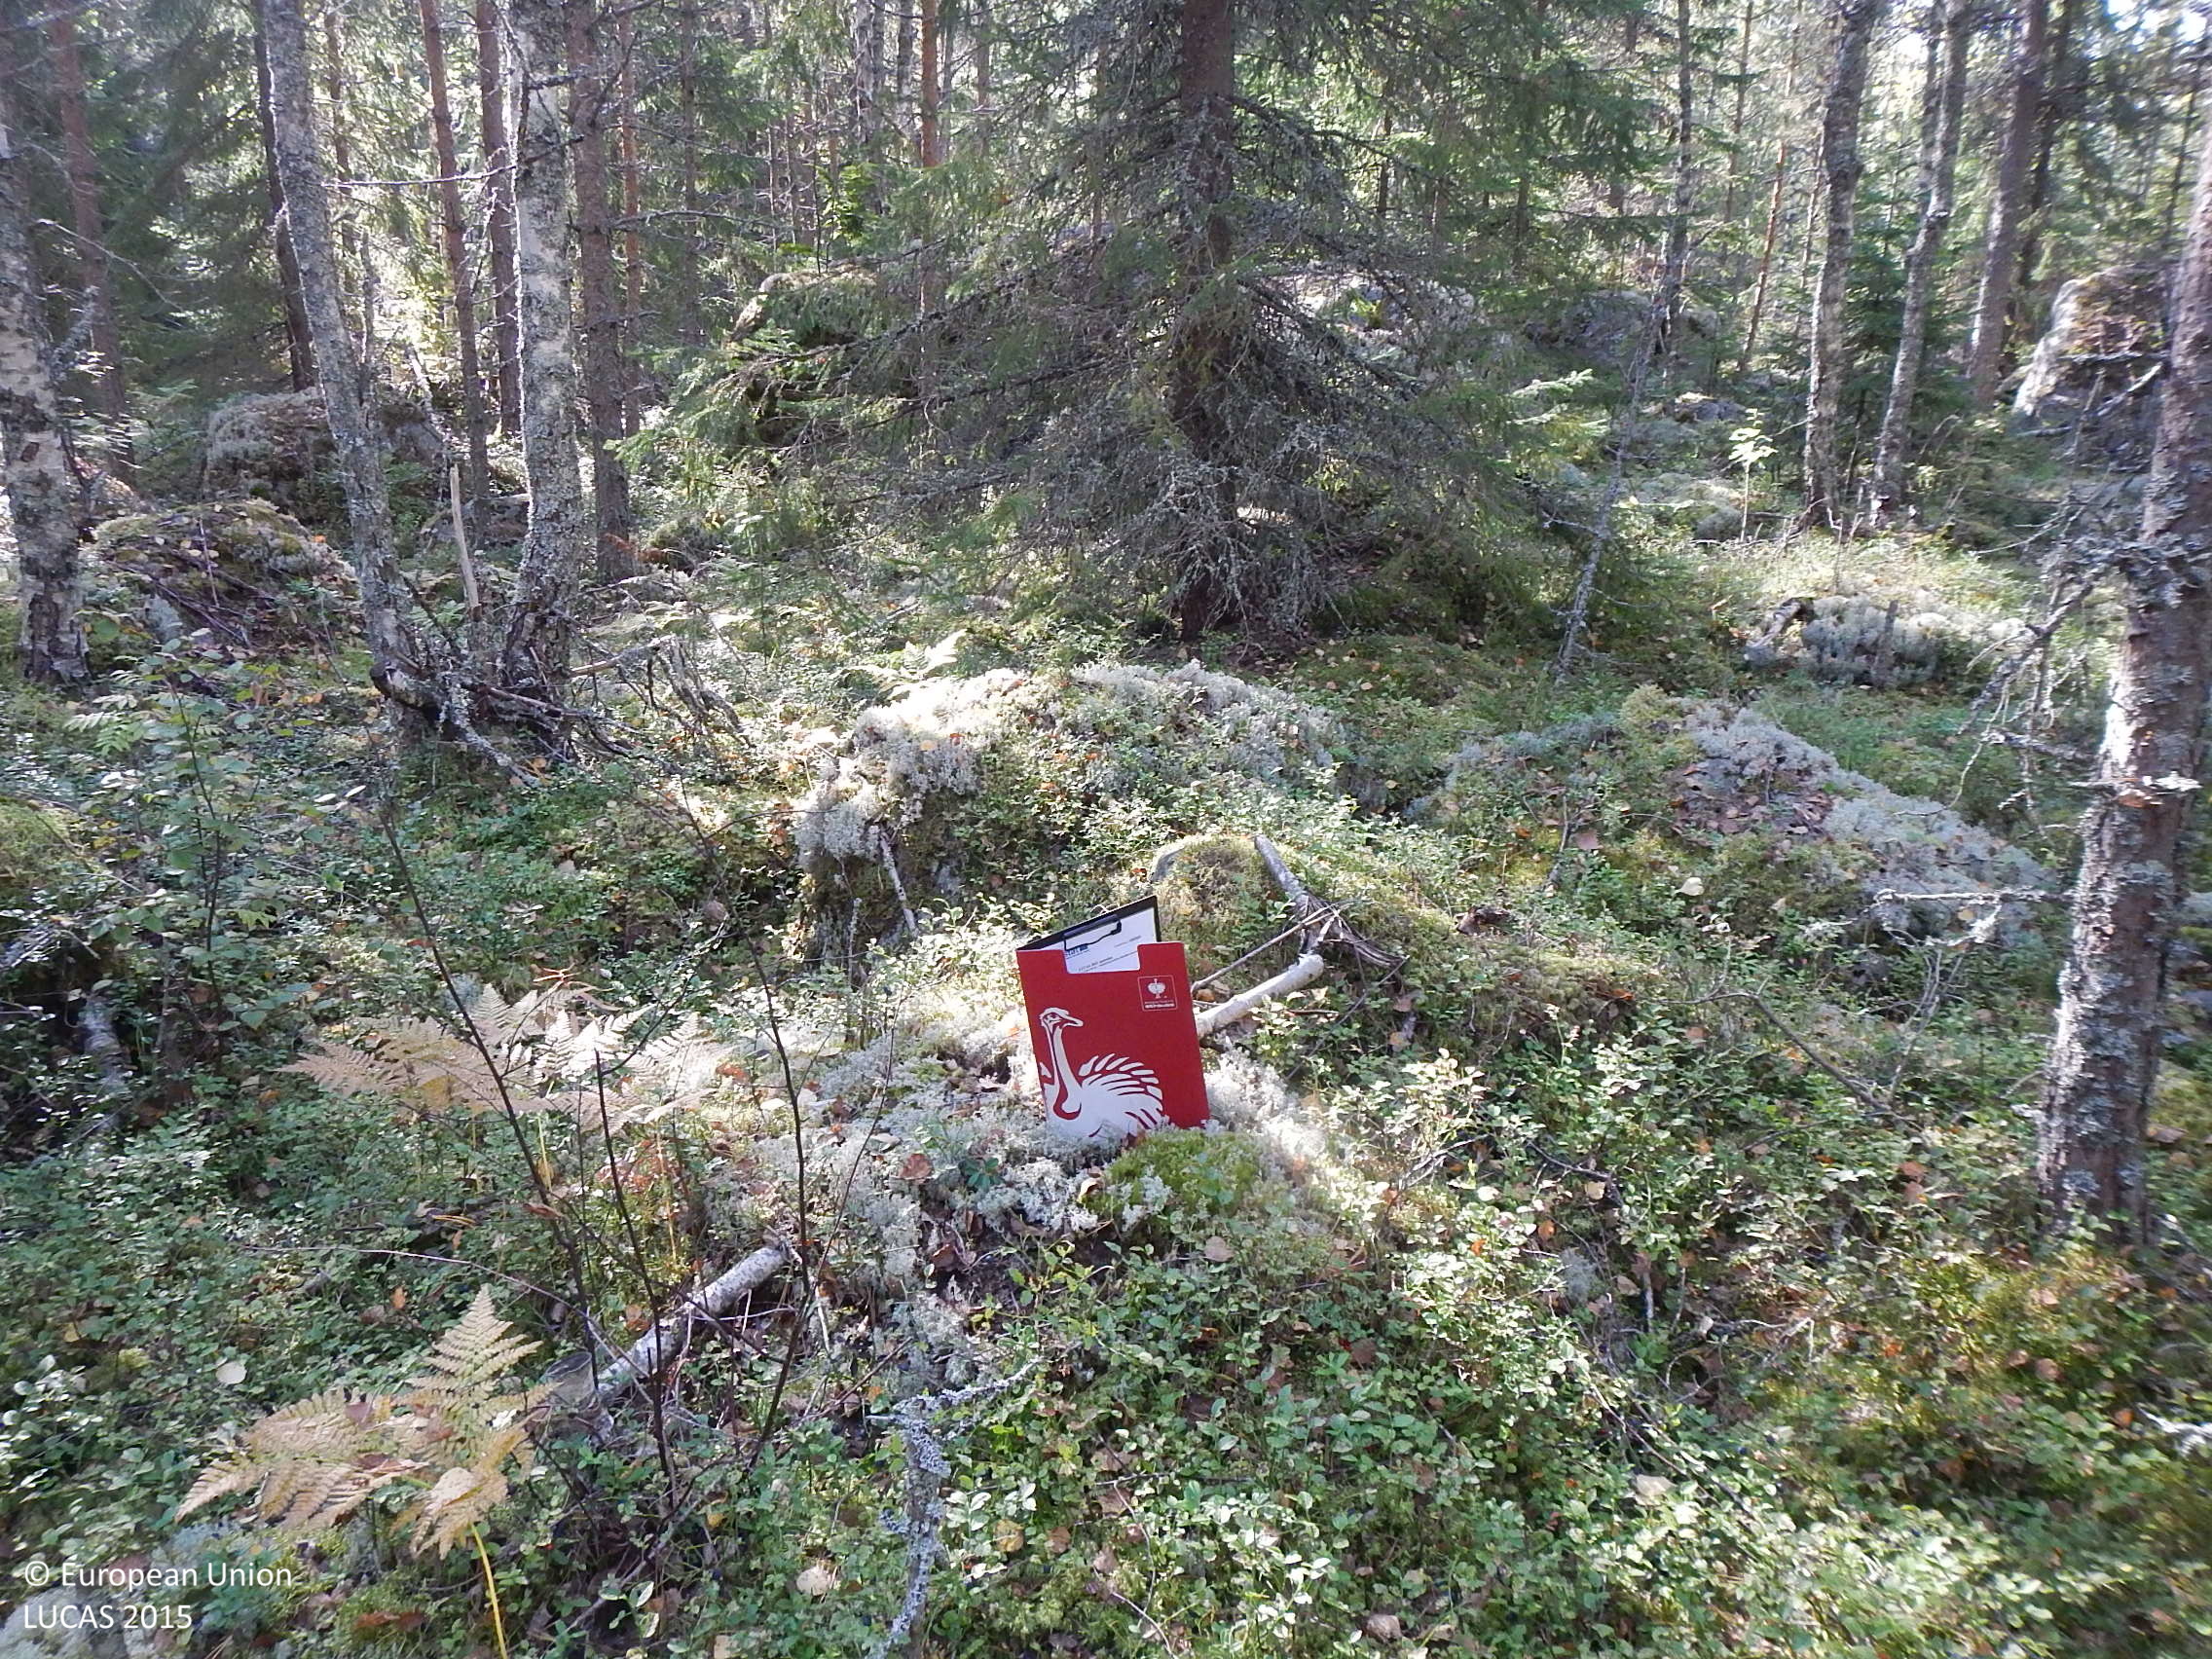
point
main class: Woodland
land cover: Other mixed woodland
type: boreal forest
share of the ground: > 75 %
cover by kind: coniferous forest trees 50 %, broadleaved forest trees 25 %, shrubs 20 %, lichens and mosses 5 %
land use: Forestry
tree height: > 5 m
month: September
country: FI
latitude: 61.5865
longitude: 22.1717
